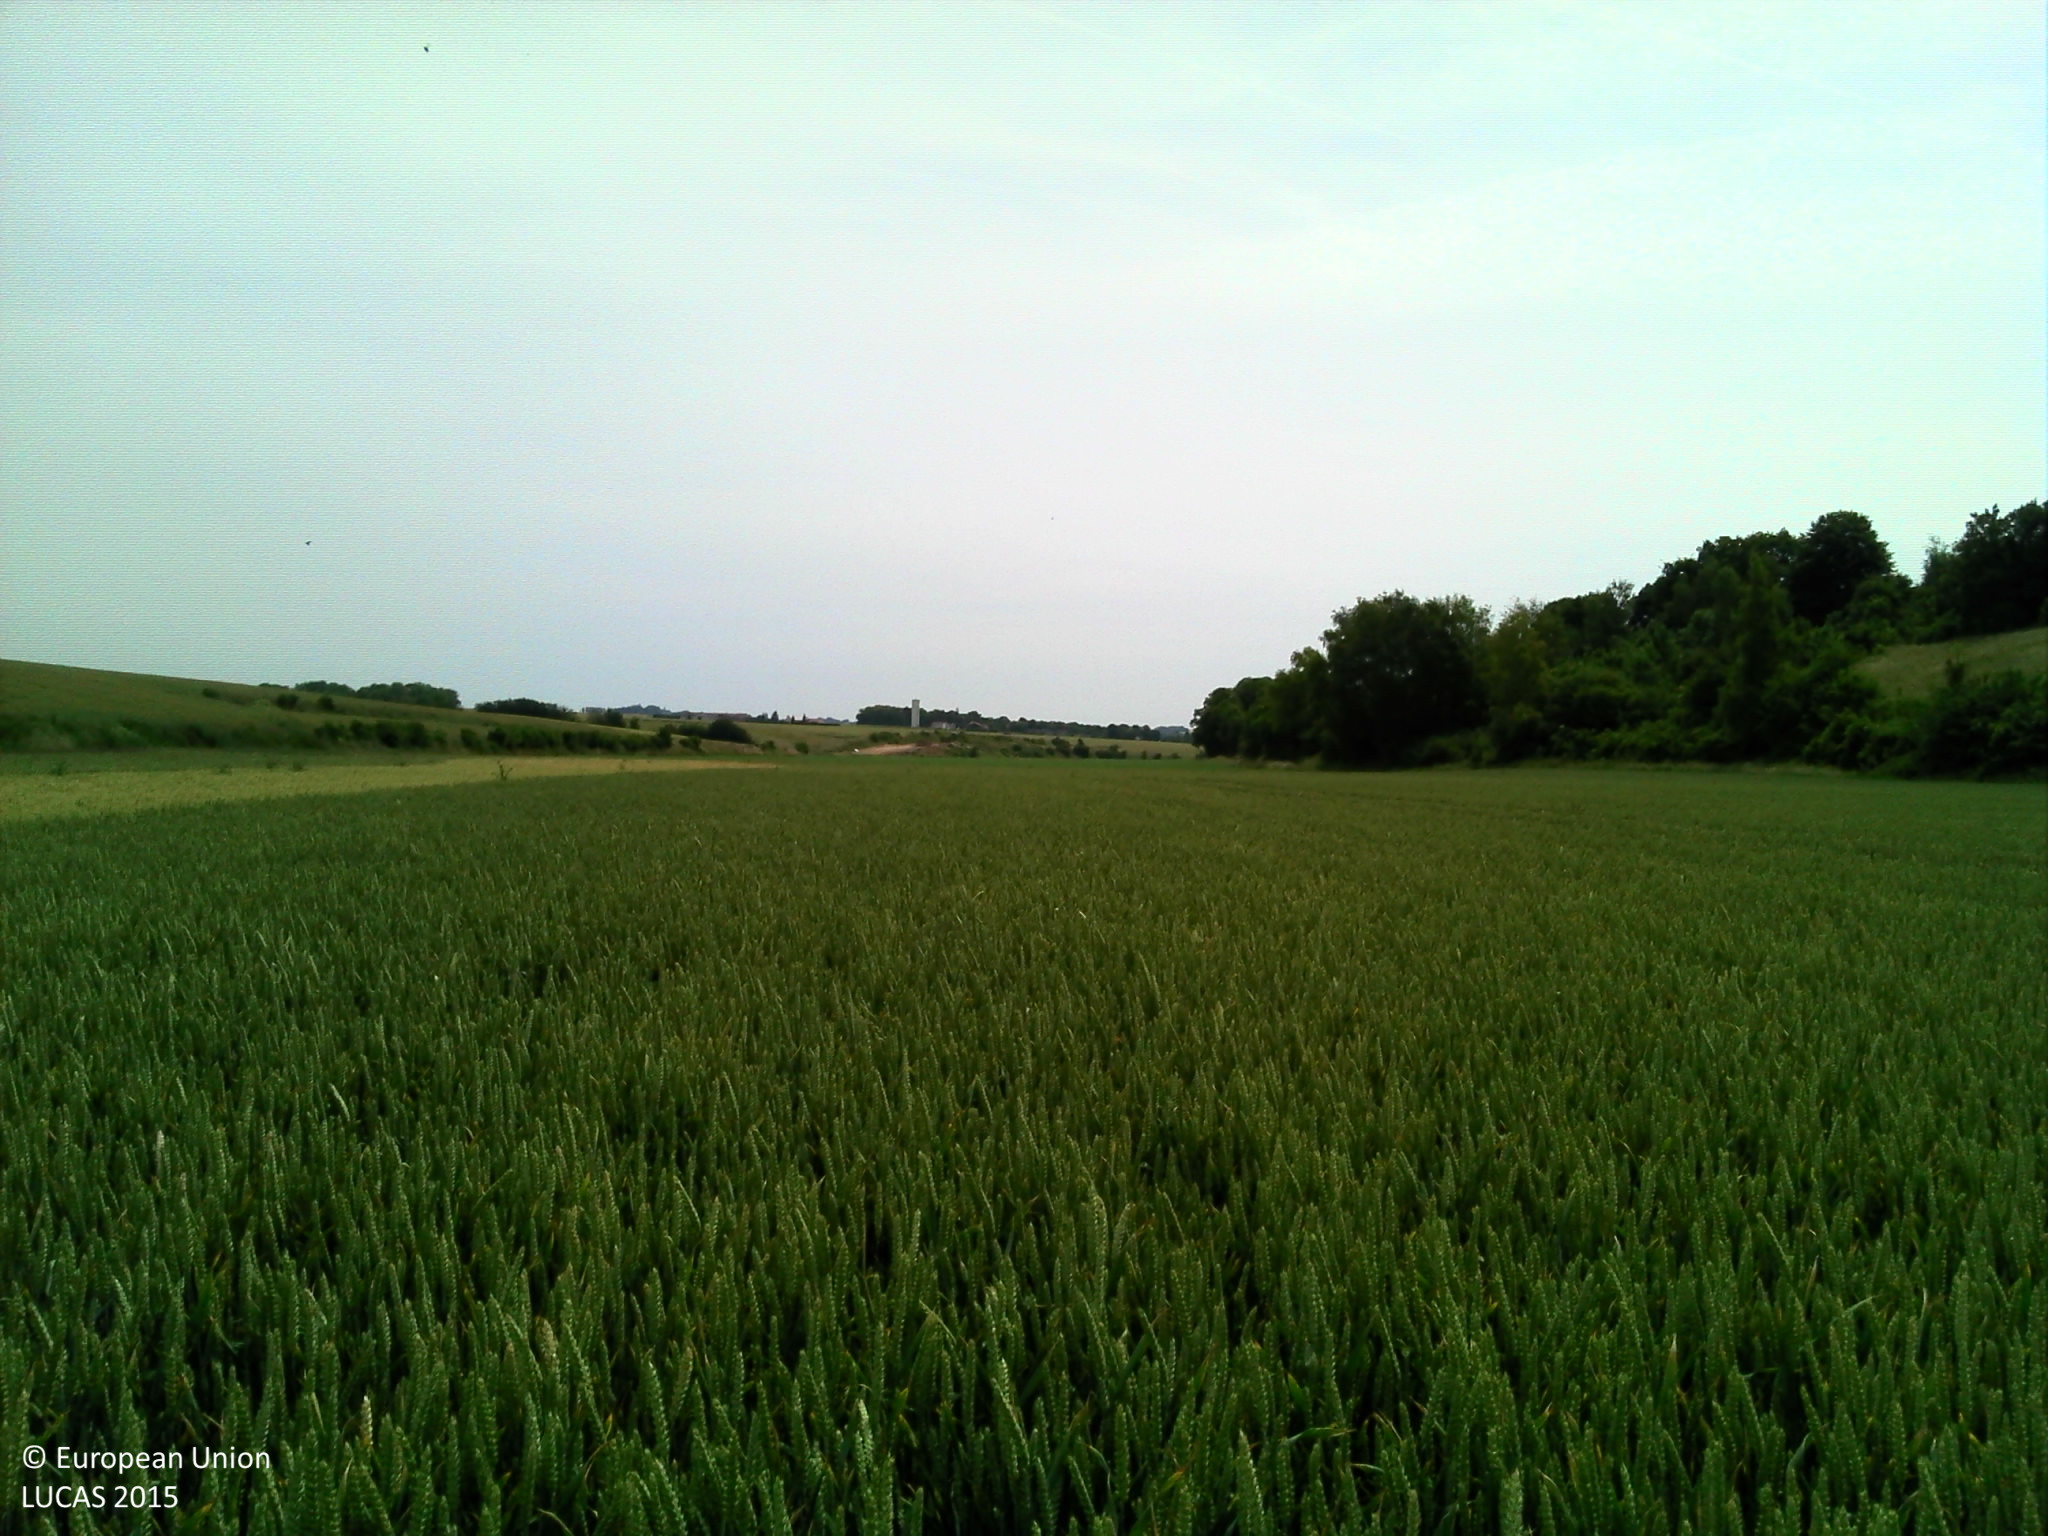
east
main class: Cropland
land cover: Common wheat
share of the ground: > 75 %
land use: Agriculture (excluding fallow land and kitchen gardens)
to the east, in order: Common wheat; Dry pulses
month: June
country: FR
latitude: 49.6705
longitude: 2.2964
